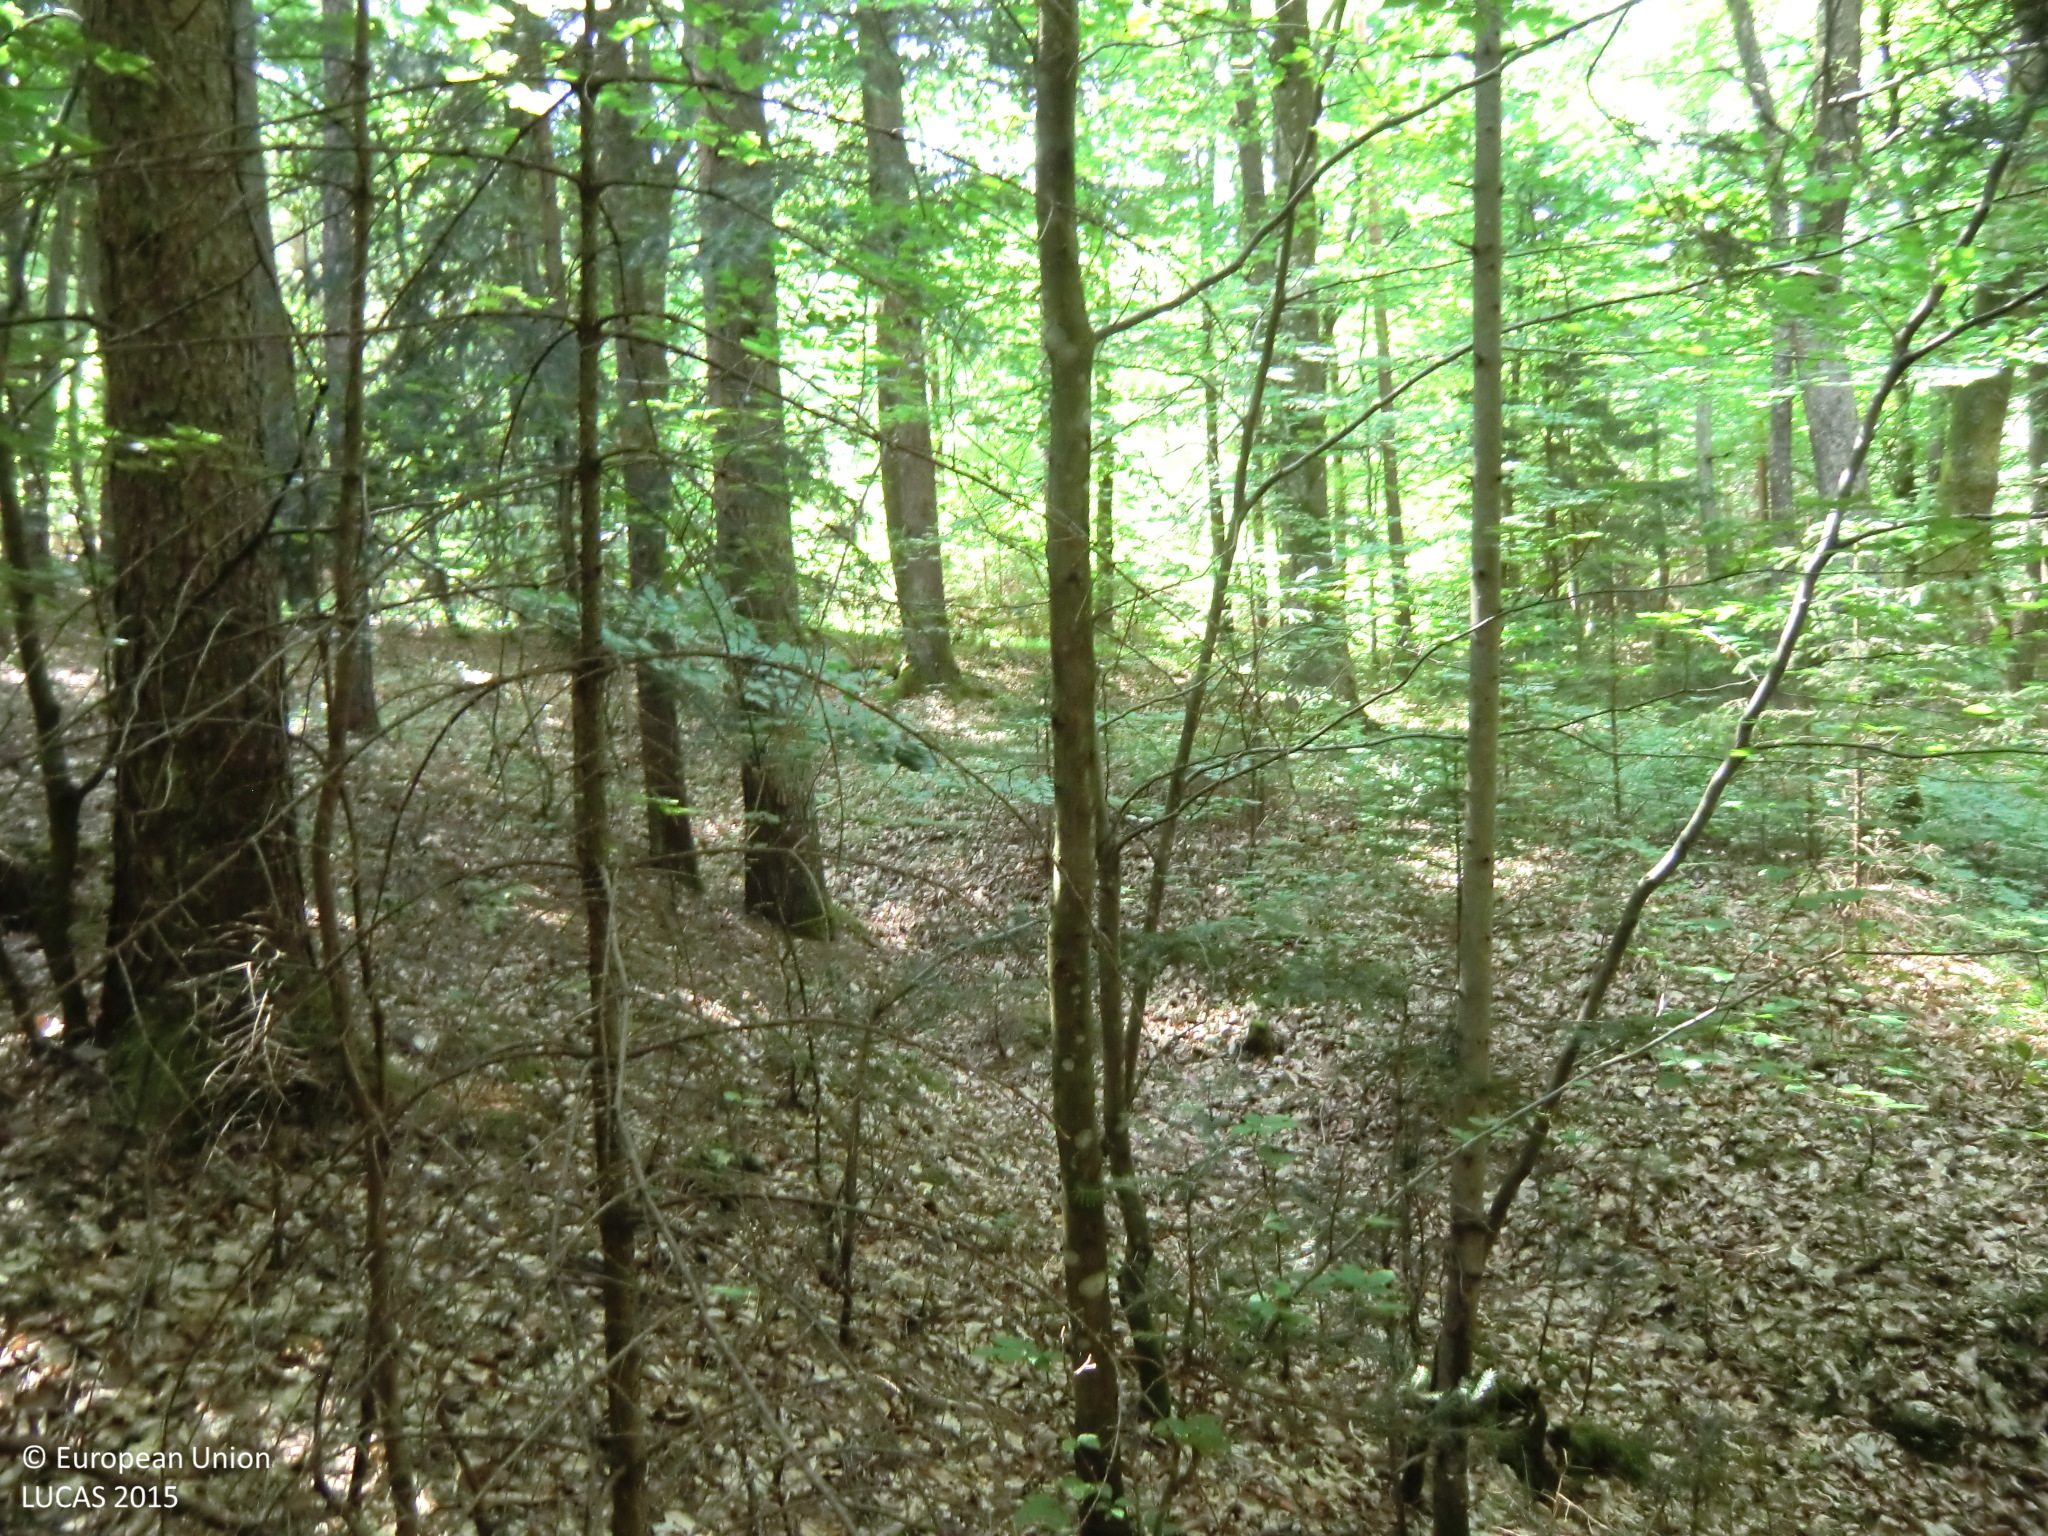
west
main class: Woodland
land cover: Spruce dominated mixed woodland
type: hemiboreal forest and nemoral coniferous forest and mixed broadleaved-coniferous forest
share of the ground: > 75 %
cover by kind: coniferous forest trees 60 %, broadleaved forest trees 35 %, unconsolidated bare surface 5 %
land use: Forestry
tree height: > 5 m
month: June
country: AT
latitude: 47.1898
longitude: 15.7419
